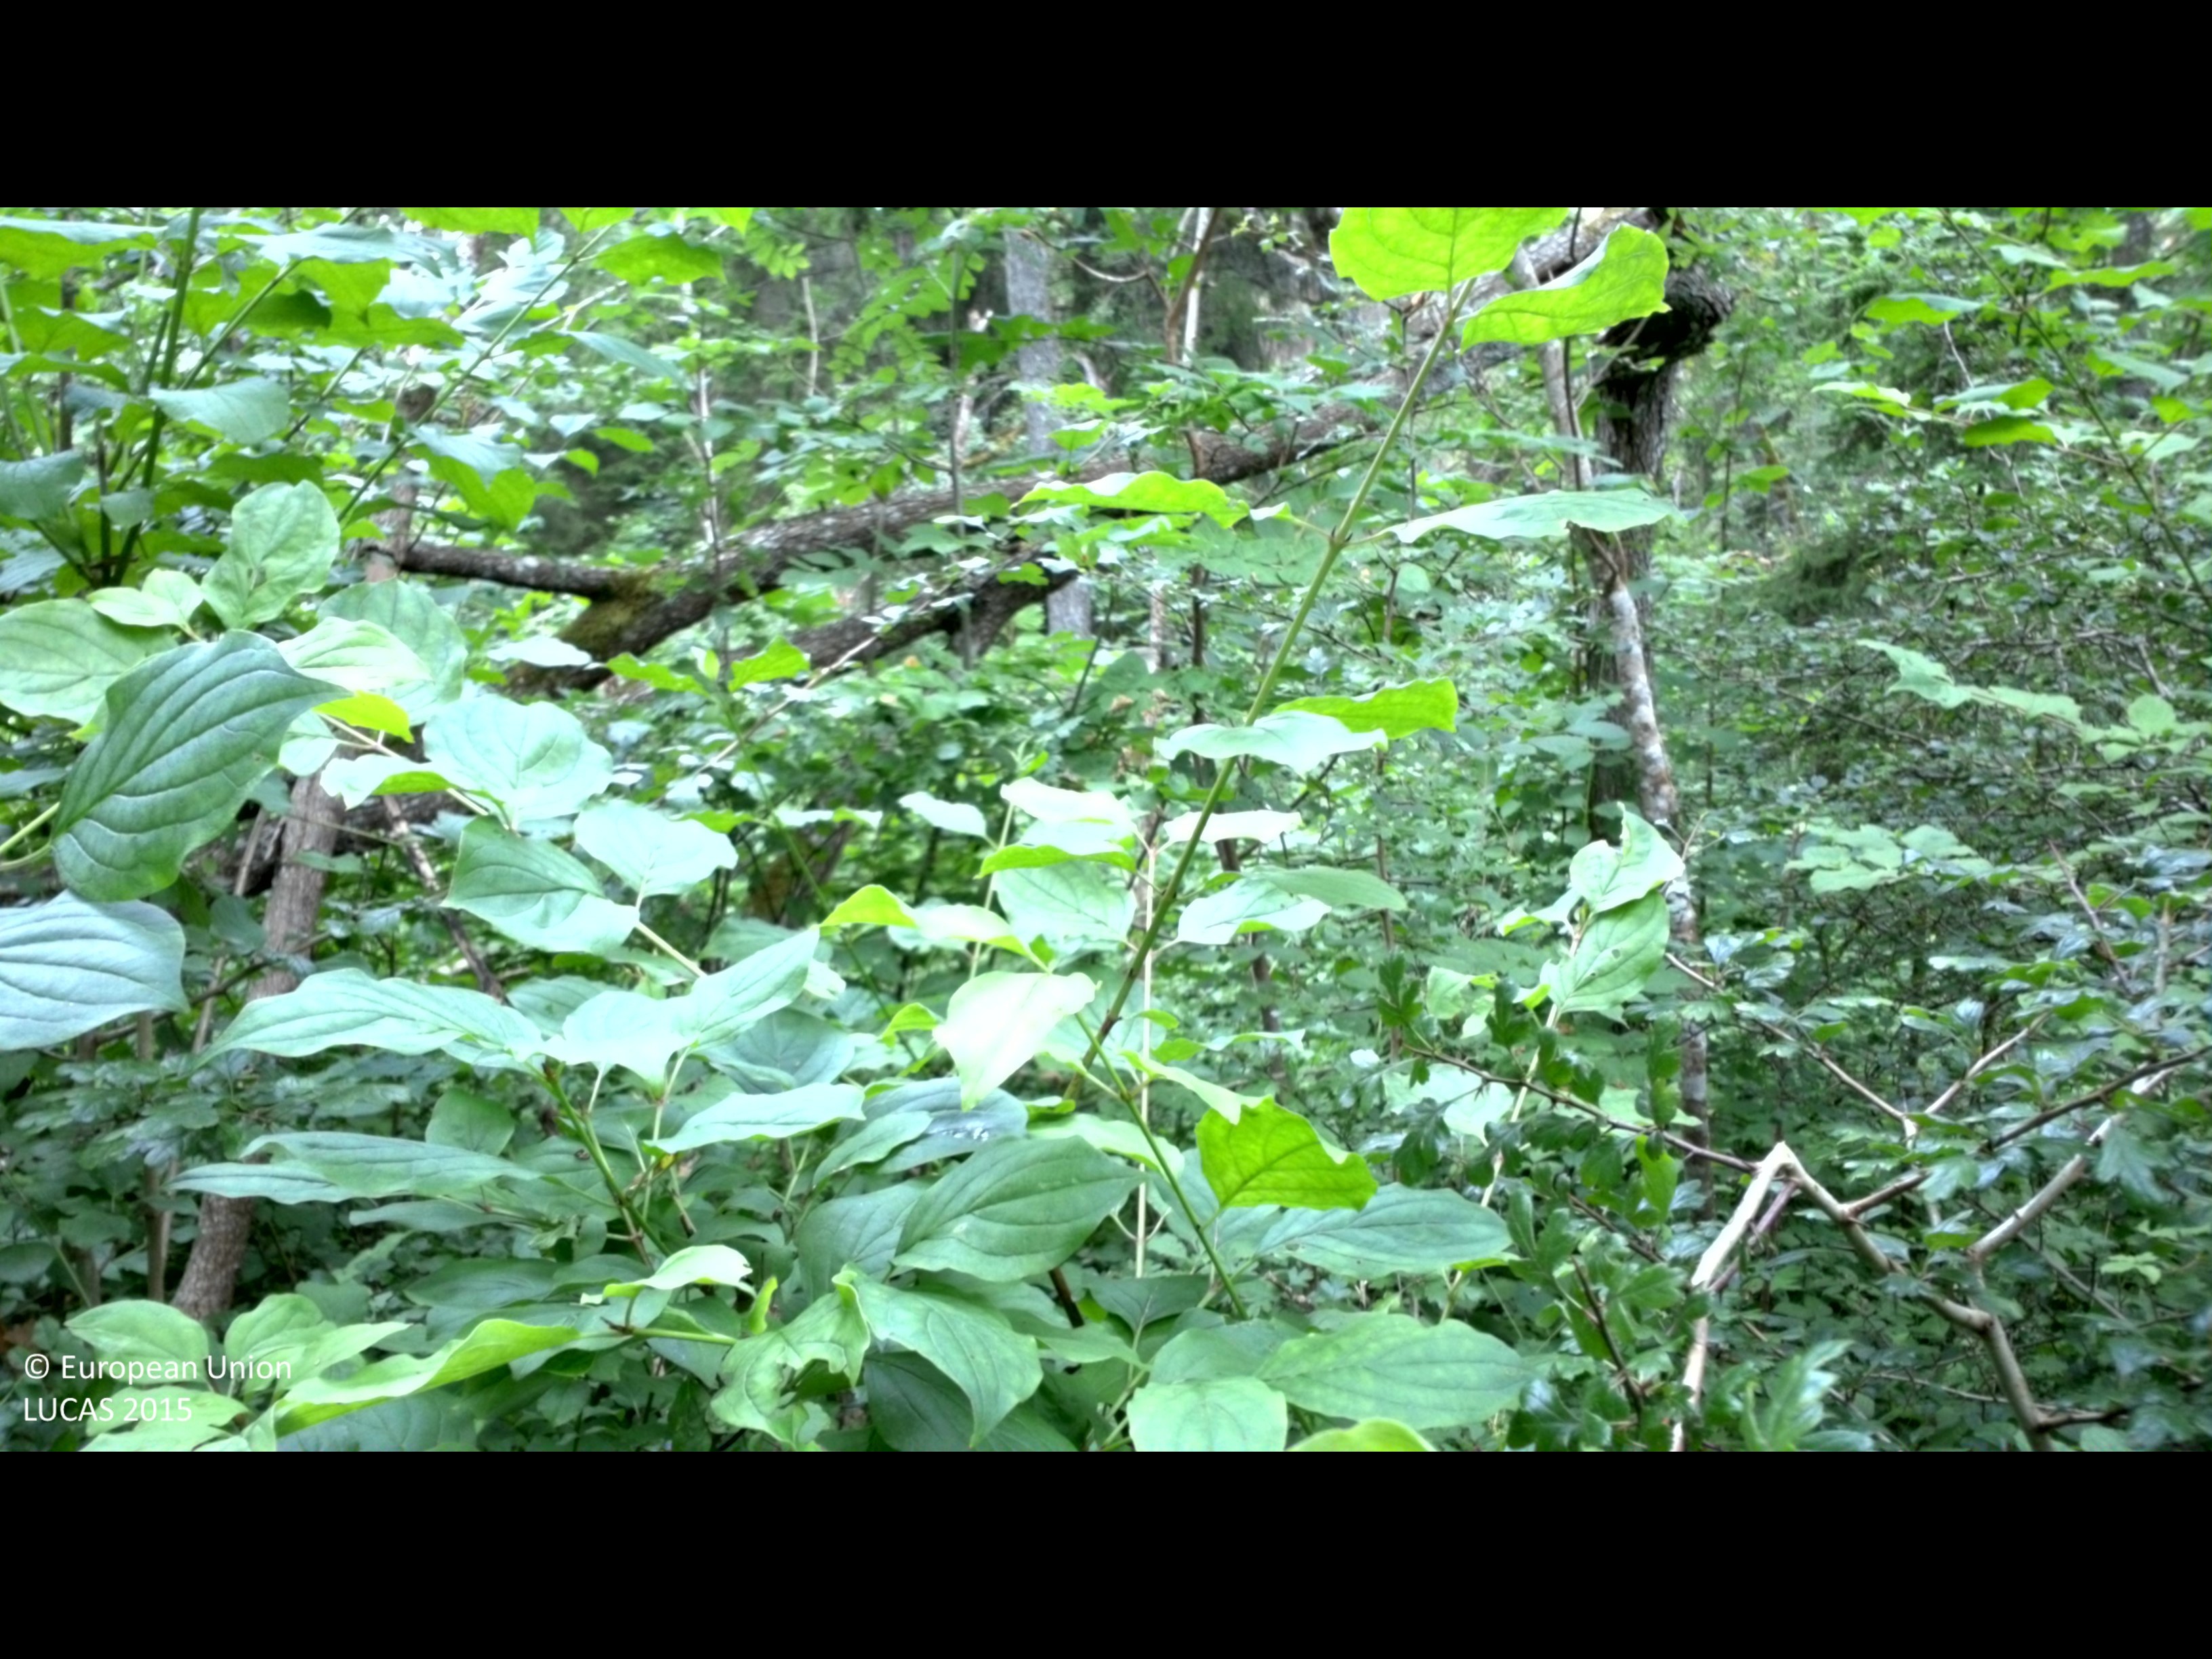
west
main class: Woodland
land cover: Broadleaved woodland
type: mesophytic deciduous forest
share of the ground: 50 - 75 %
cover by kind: broadleaved forest trees 50 %, shrubs 30 %, coniferous forest trees 15 %, herbaceous plants 5 %
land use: Forestry
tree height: > 5 m
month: July
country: SE
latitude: 56.7419
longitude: 16.5576
